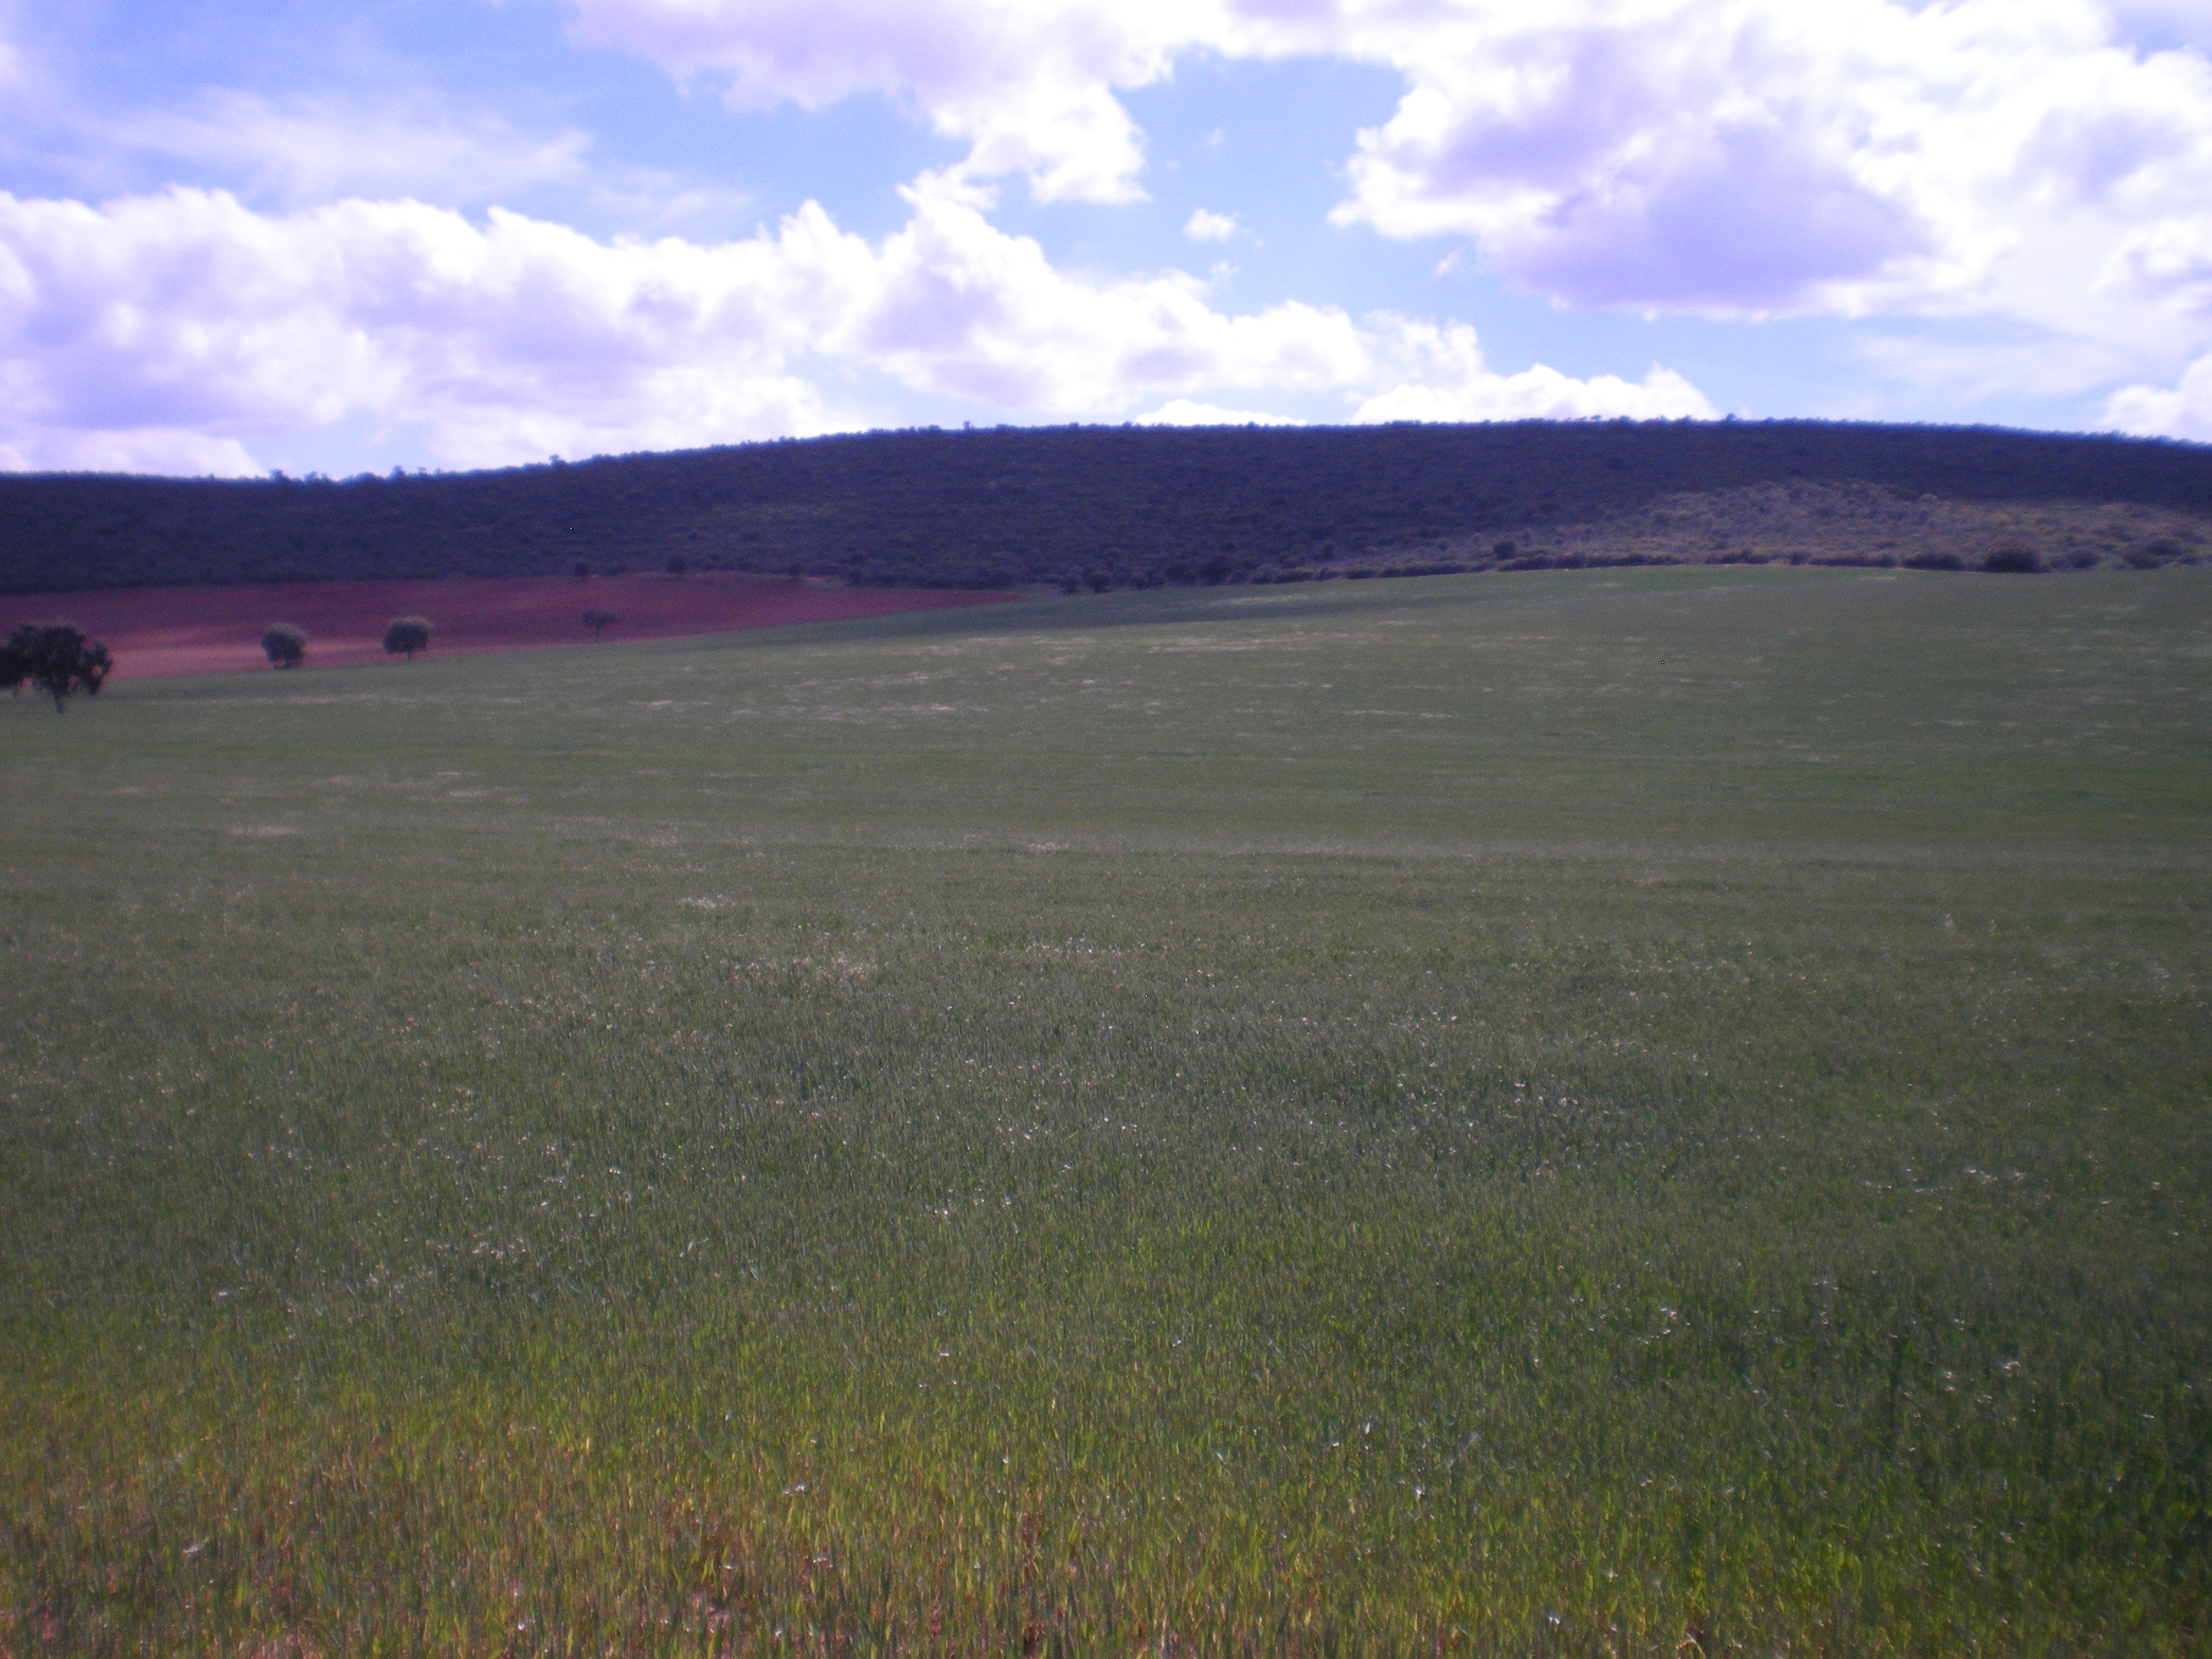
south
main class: Cropland
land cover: Common wheat
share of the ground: > 75 %
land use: Agriculture (excluding fallow land and kitchen gardens)
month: April
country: ES
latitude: 38.7503
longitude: -3.5789
